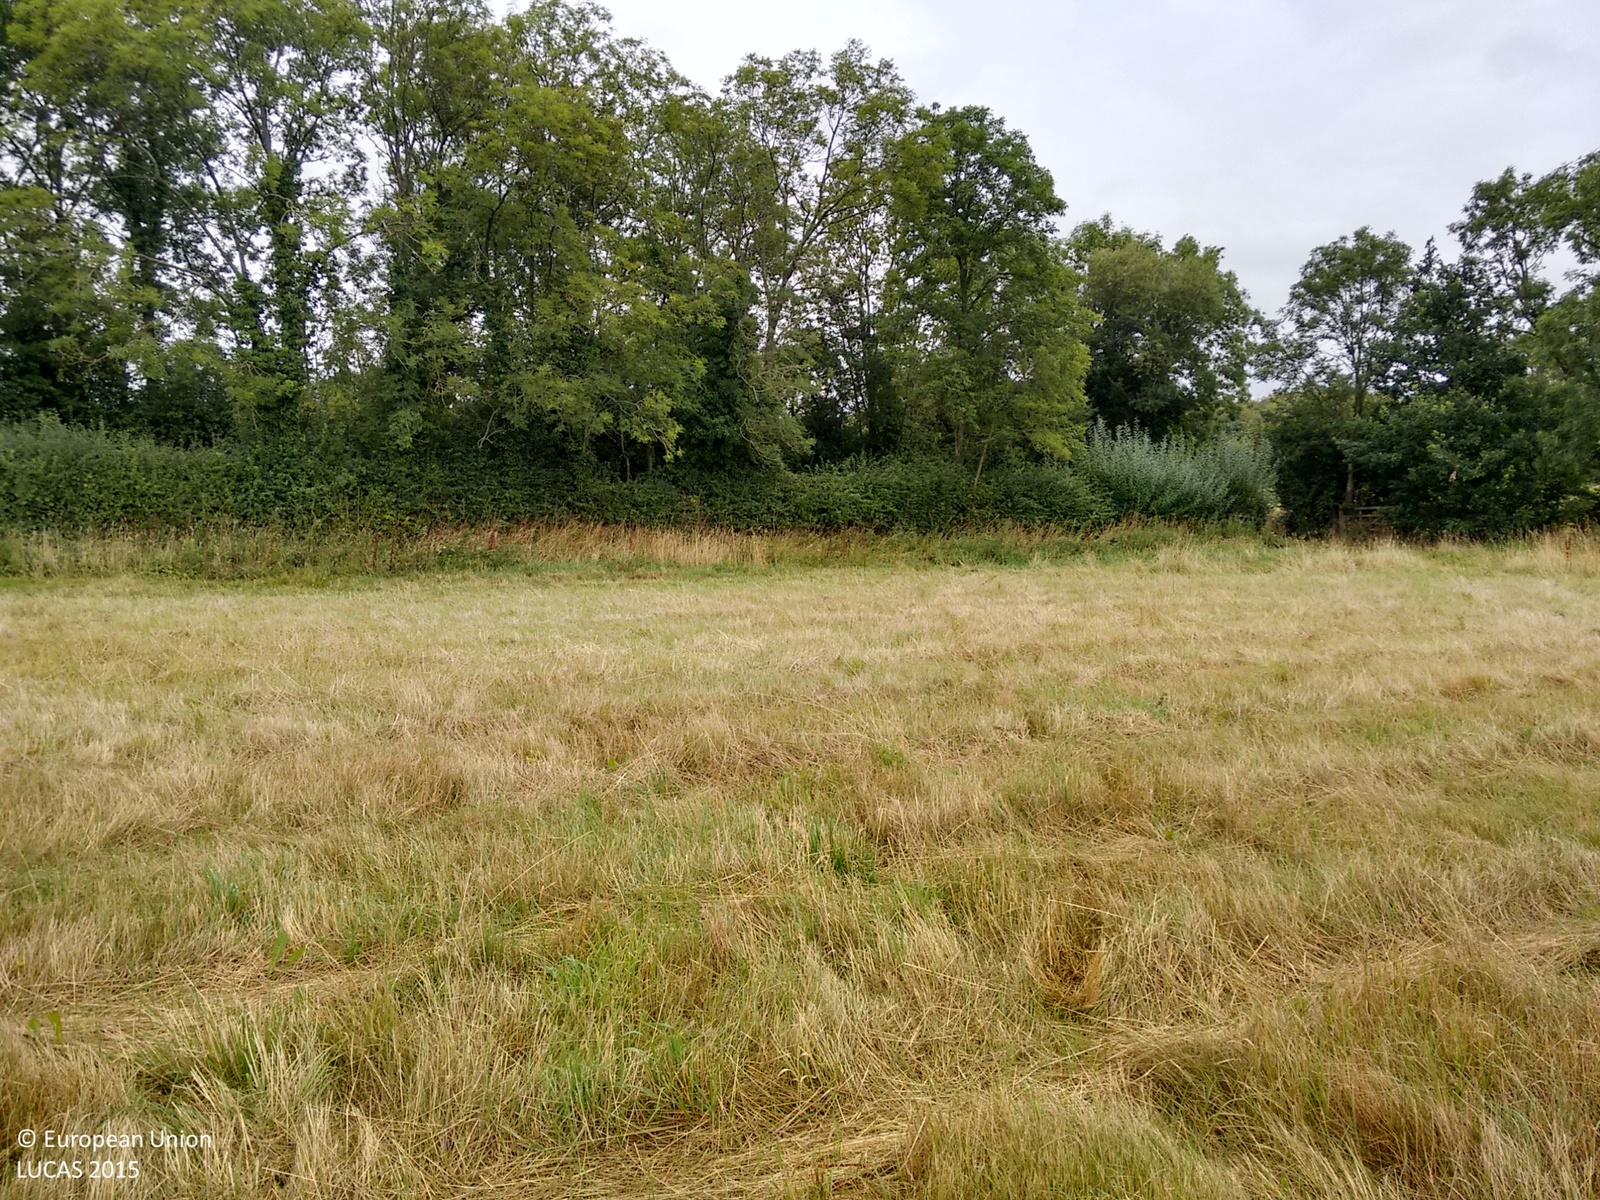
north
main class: Grassland
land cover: Grassland without tree/shrub cover
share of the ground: > 75 %
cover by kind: herbaceous plants 100 %
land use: Agriculture (excluding fallow land and kitchen gardens)
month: August
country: GB
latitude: 52.1543
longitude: -1.1991
